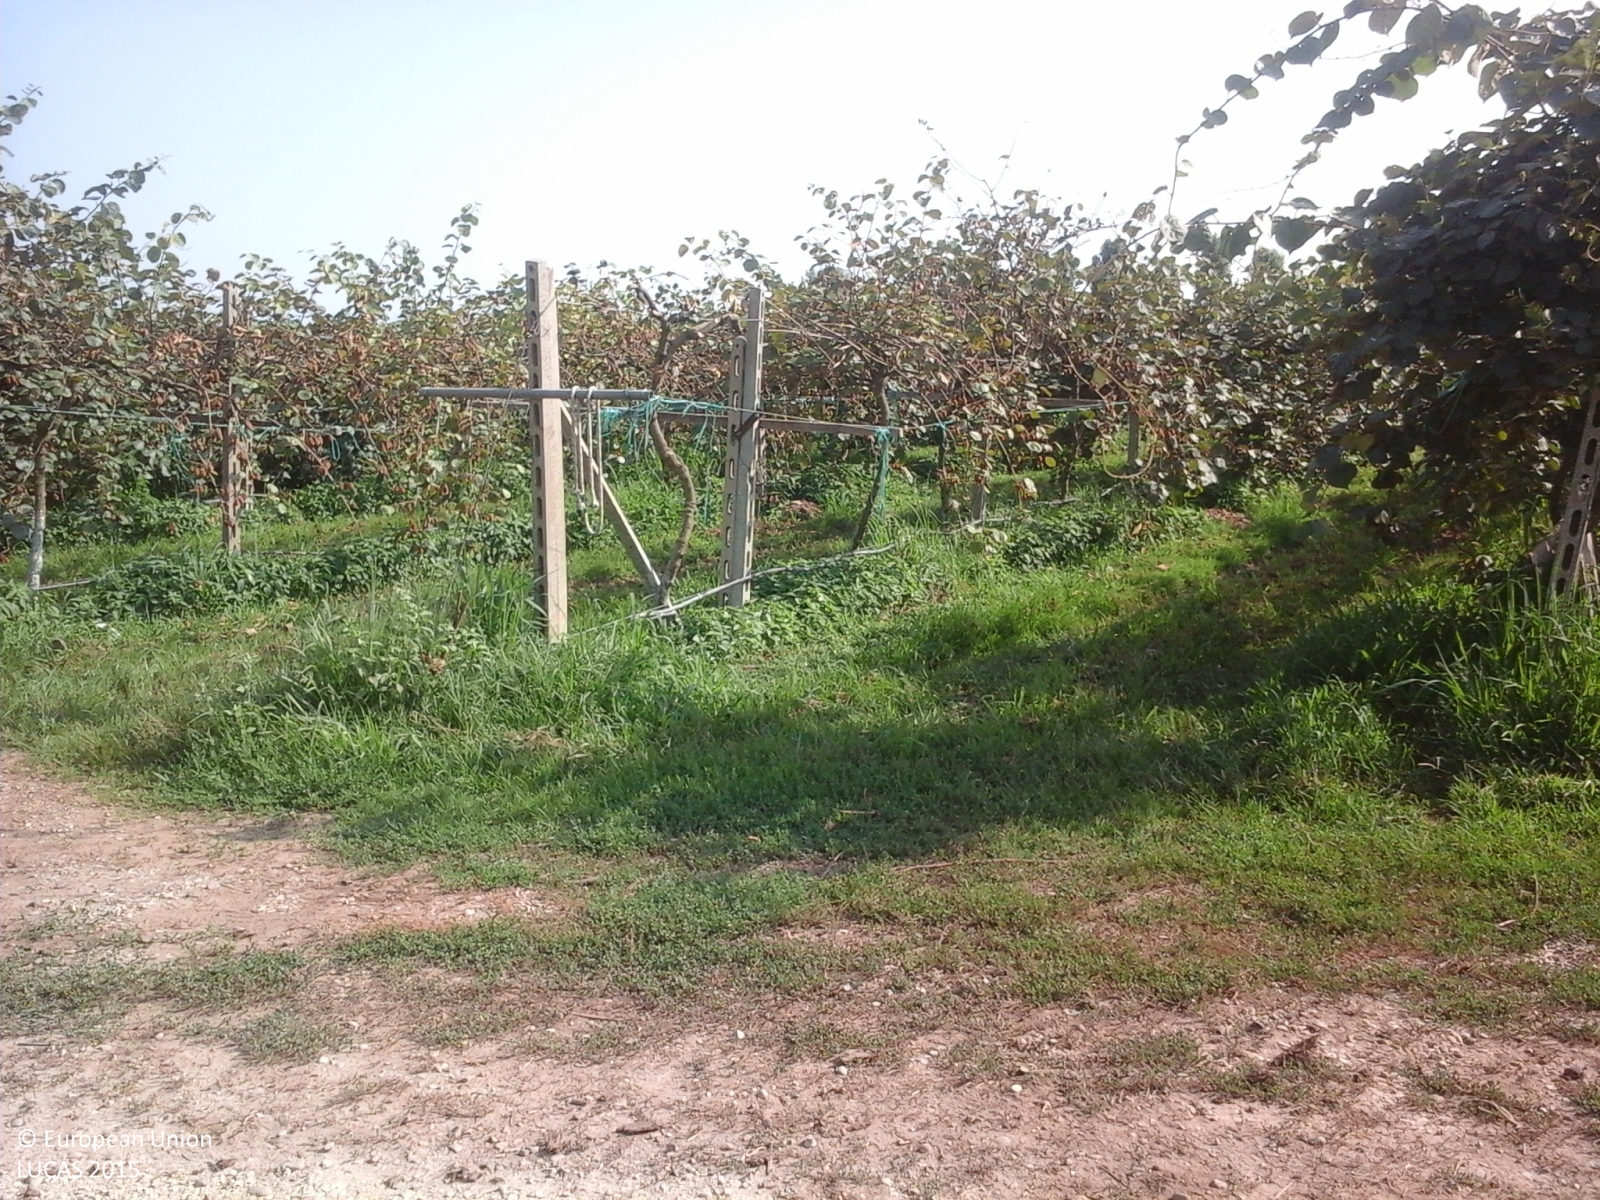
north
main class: Cropland
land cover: Maize
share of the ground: 50 - 75 %
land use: Agriculture (excluding fallow land and kitchen gardens)
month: July
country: IT
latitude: 45.3389
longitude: 10.8280
